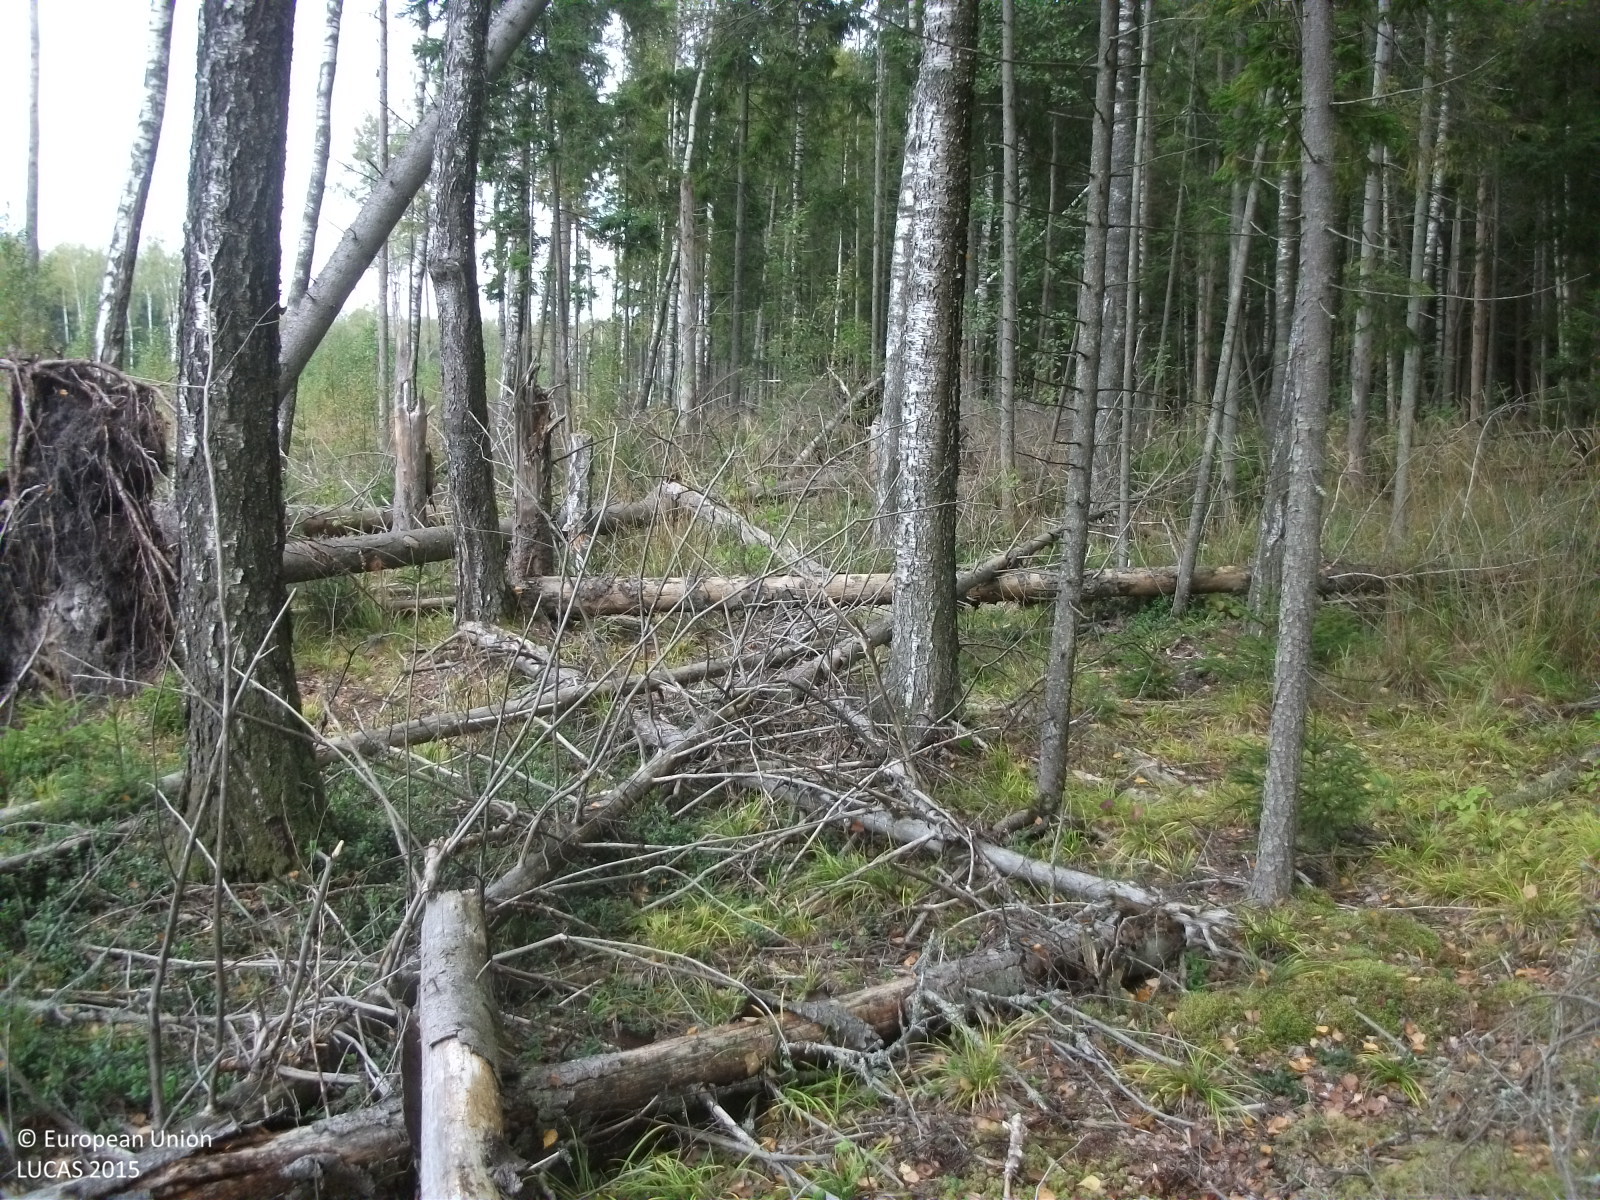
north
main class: Woodland
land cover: Spruce dominated mixed woodland
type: hemiboreal forest and nemoral coniferous forest and mixed broadleaved-coniferous forest
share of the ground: > 75 %
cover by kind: coniferous forest trees 50 %, broadleaved forest trees 30 %, herbaceous plants 10 %, shrubs 5 %
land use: Forestry
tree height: > 5 m
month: September
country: LV
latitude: 57.7826
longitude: 24.4332
